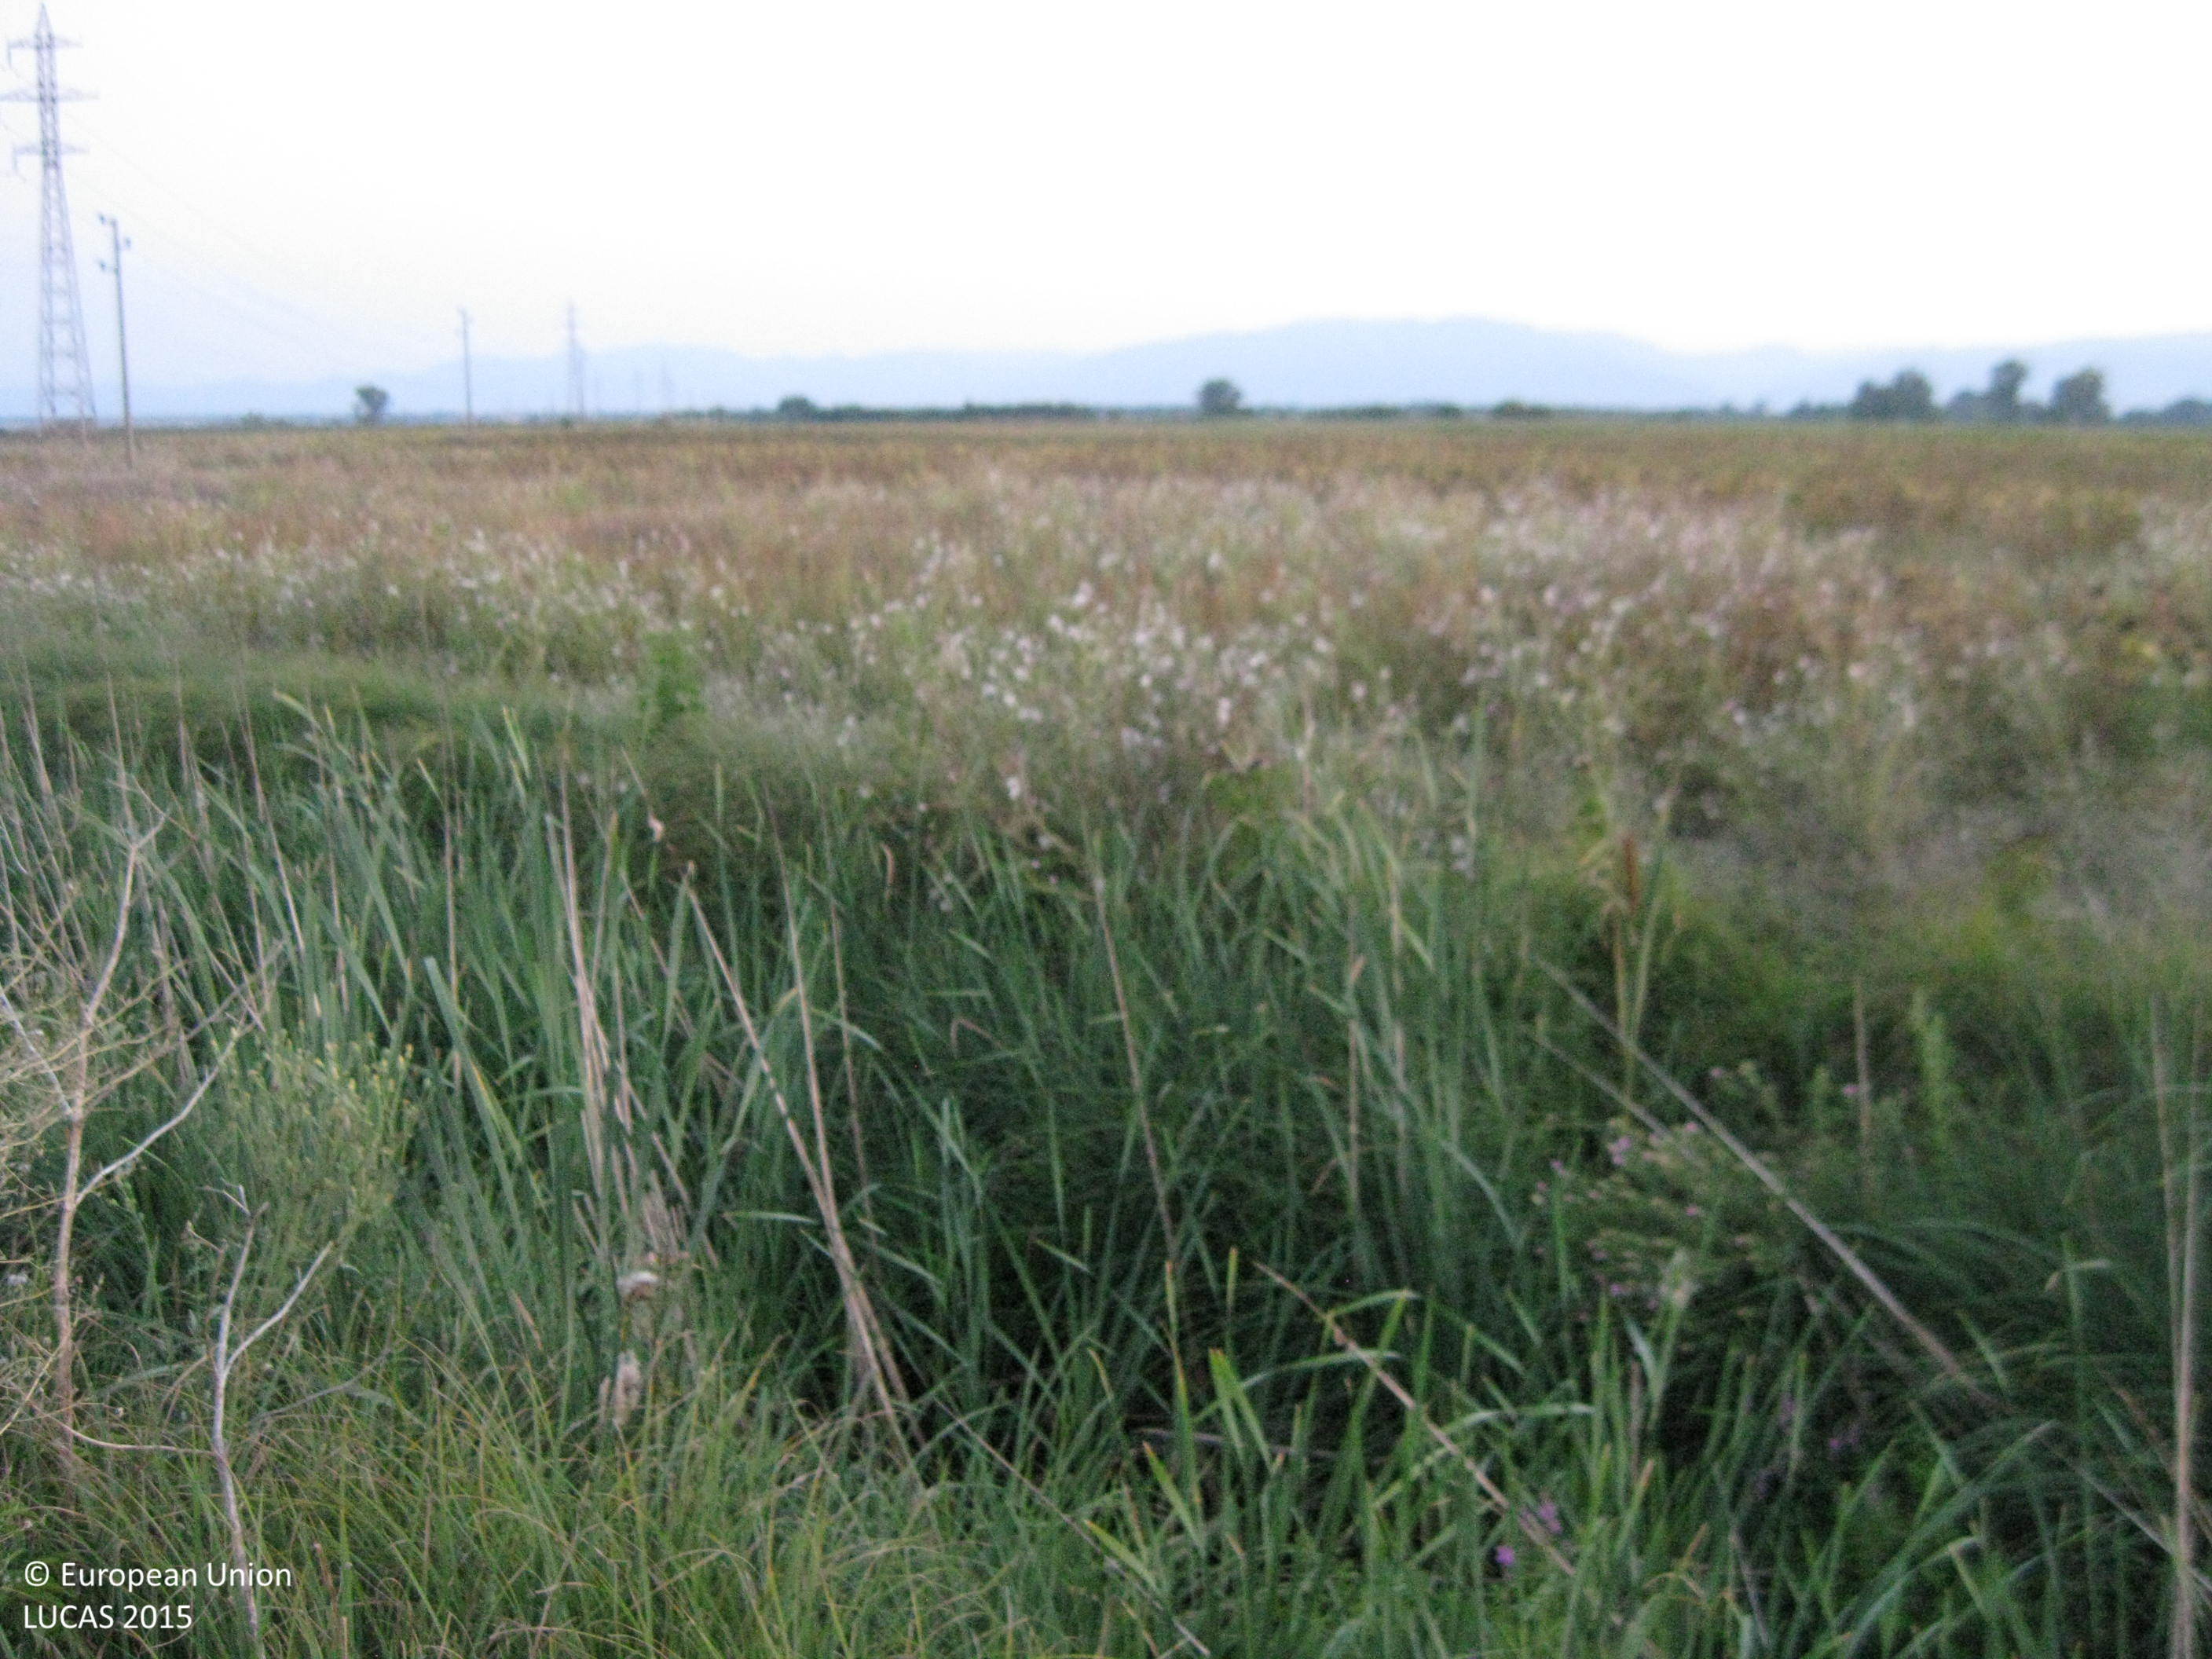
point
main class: Cropland
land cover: Sunflower
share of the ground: 50 - 75 %
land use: Agriculture (excluding fallow land and kitchen gardens)
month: August
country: BG
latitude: 42.1777
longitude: 24.9588
